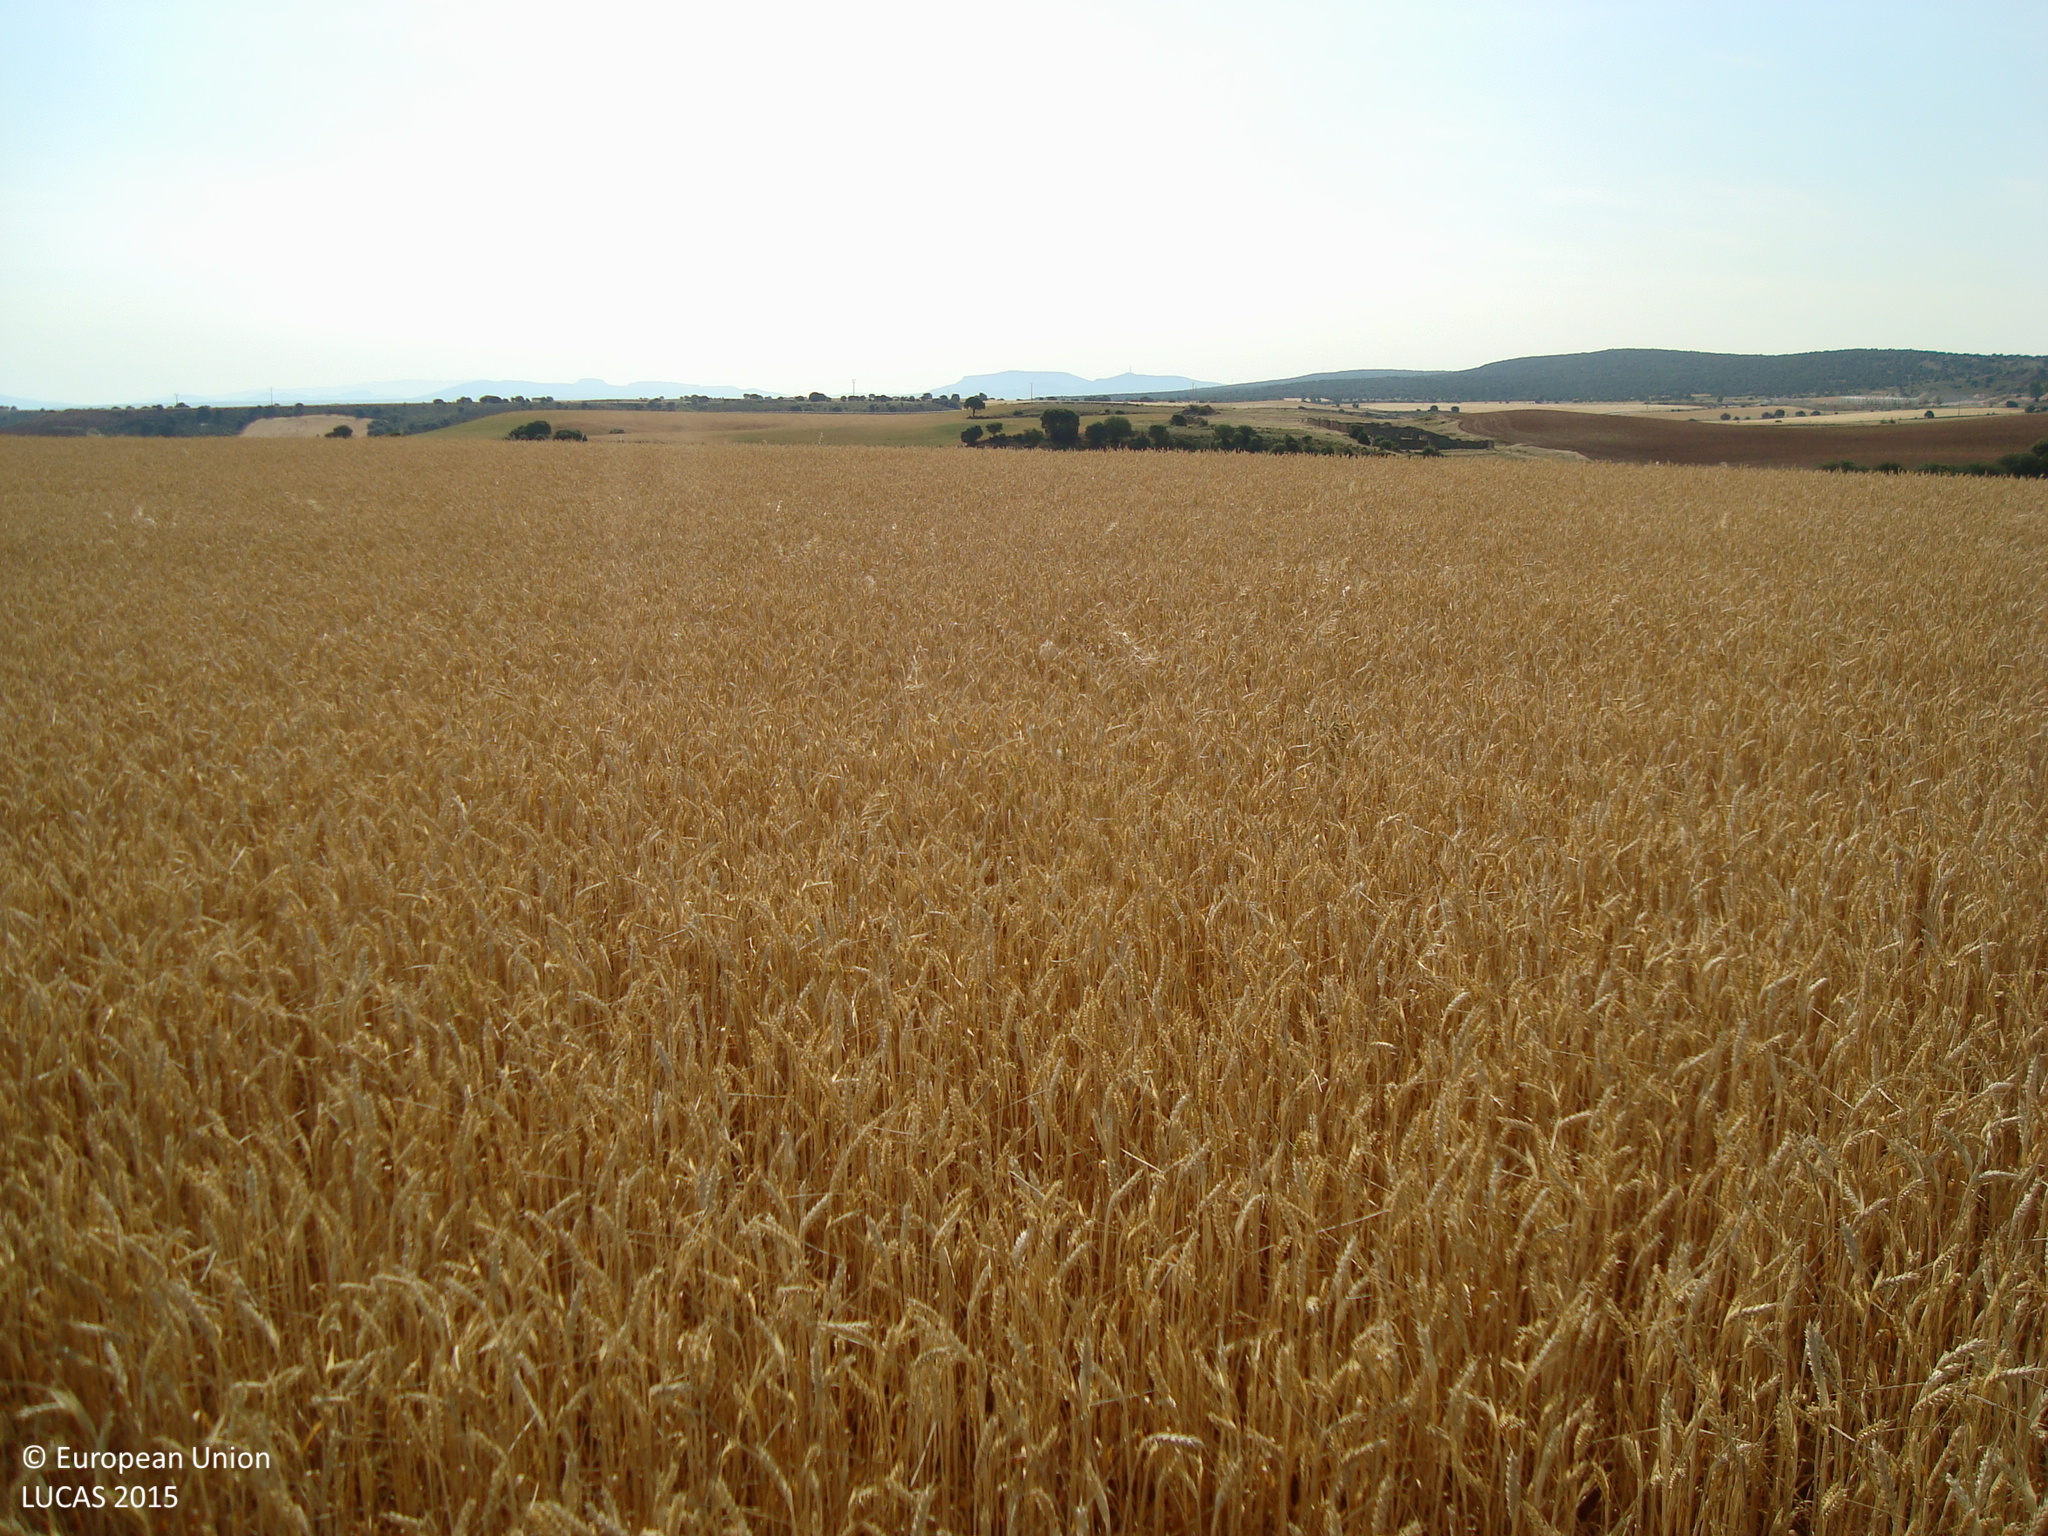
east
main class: Cropland
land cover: Common wheat
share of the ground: > 75 %
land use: Agriculture (excluding fallow land and kitchen gardens)
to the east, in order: Common wheat; Grass margins; Tracks; Grass margins; Common wheat; Tracks
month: June
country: ES
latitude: 41.9815
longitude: -3.7805
